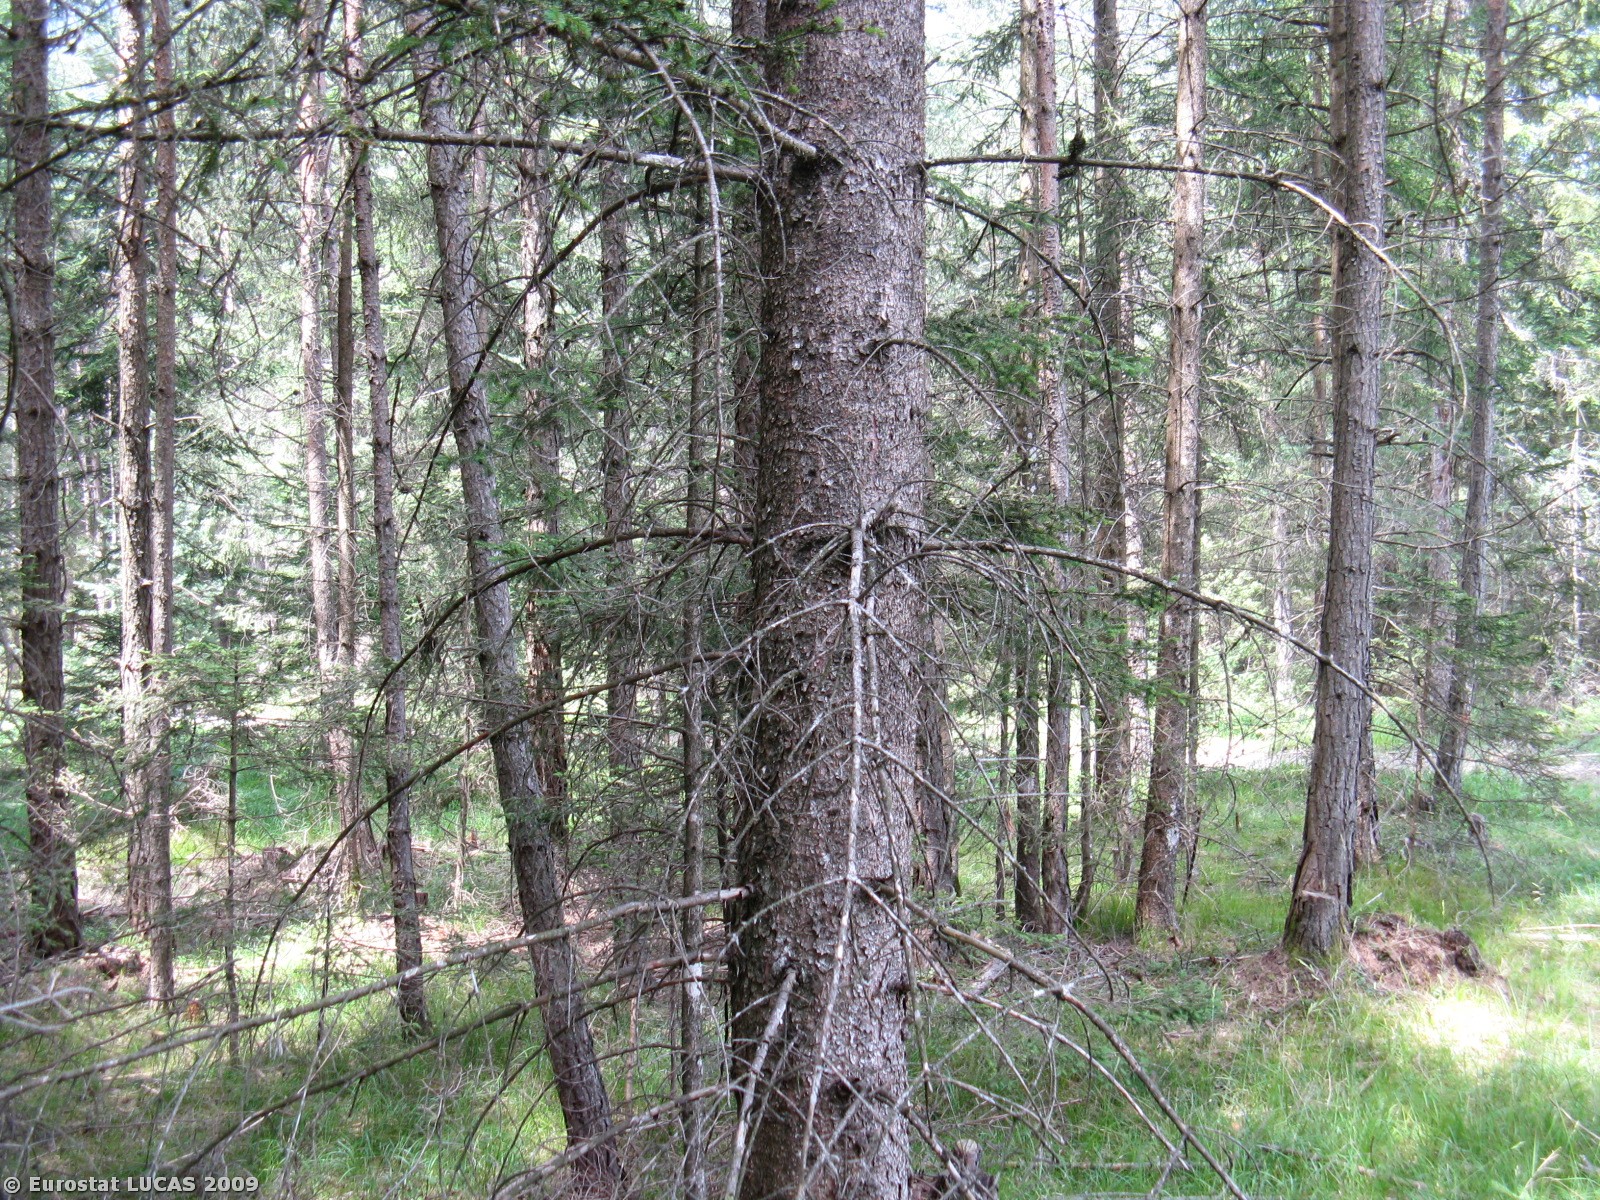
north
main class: Woodland
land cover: Coniferous woodland
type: alpine coniferous forest
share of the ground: 50 - 75 %
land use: Forestry
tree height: > 5 m
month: July
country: AT
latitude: 47.3015
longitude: 10.9381
